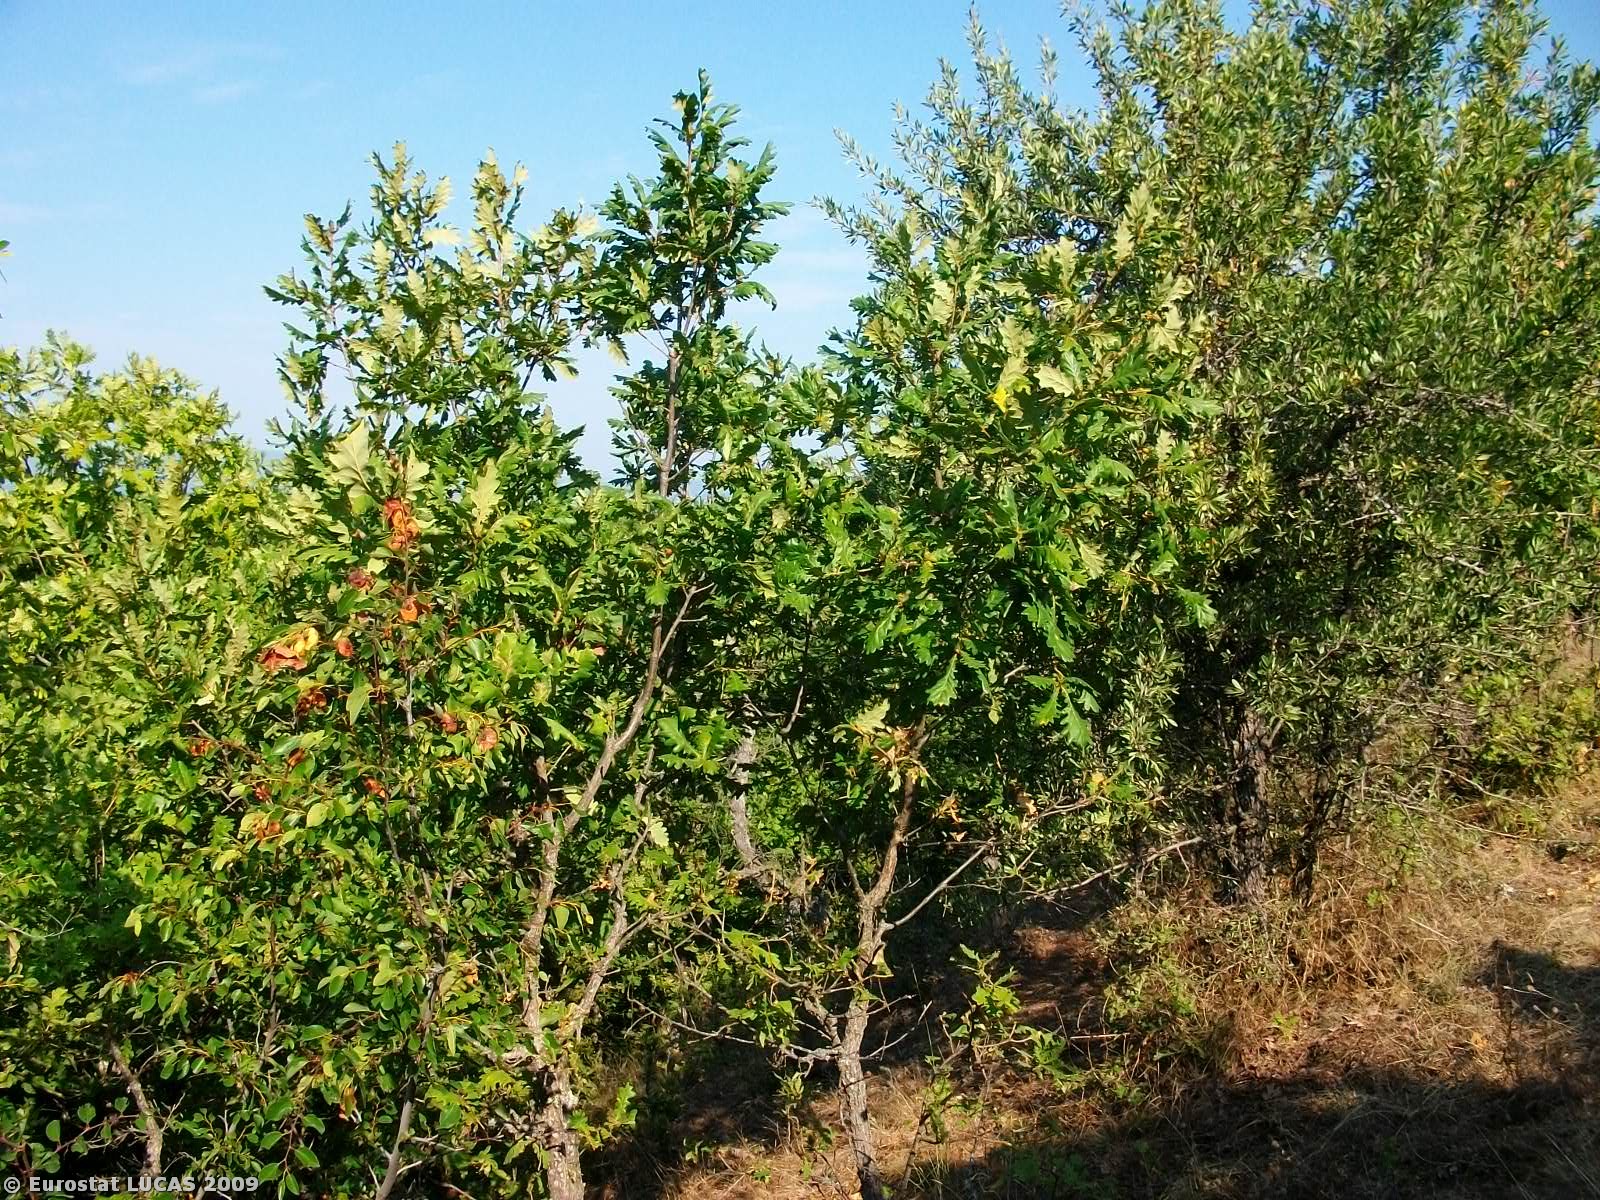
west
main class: Woodland
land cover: Broadleaved woodland
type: thermophilous deciduous forest
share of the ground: > 75 %
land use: Forestry
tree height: > 5 m
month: August
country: GR
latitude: 39.9093
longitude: 21.7199
